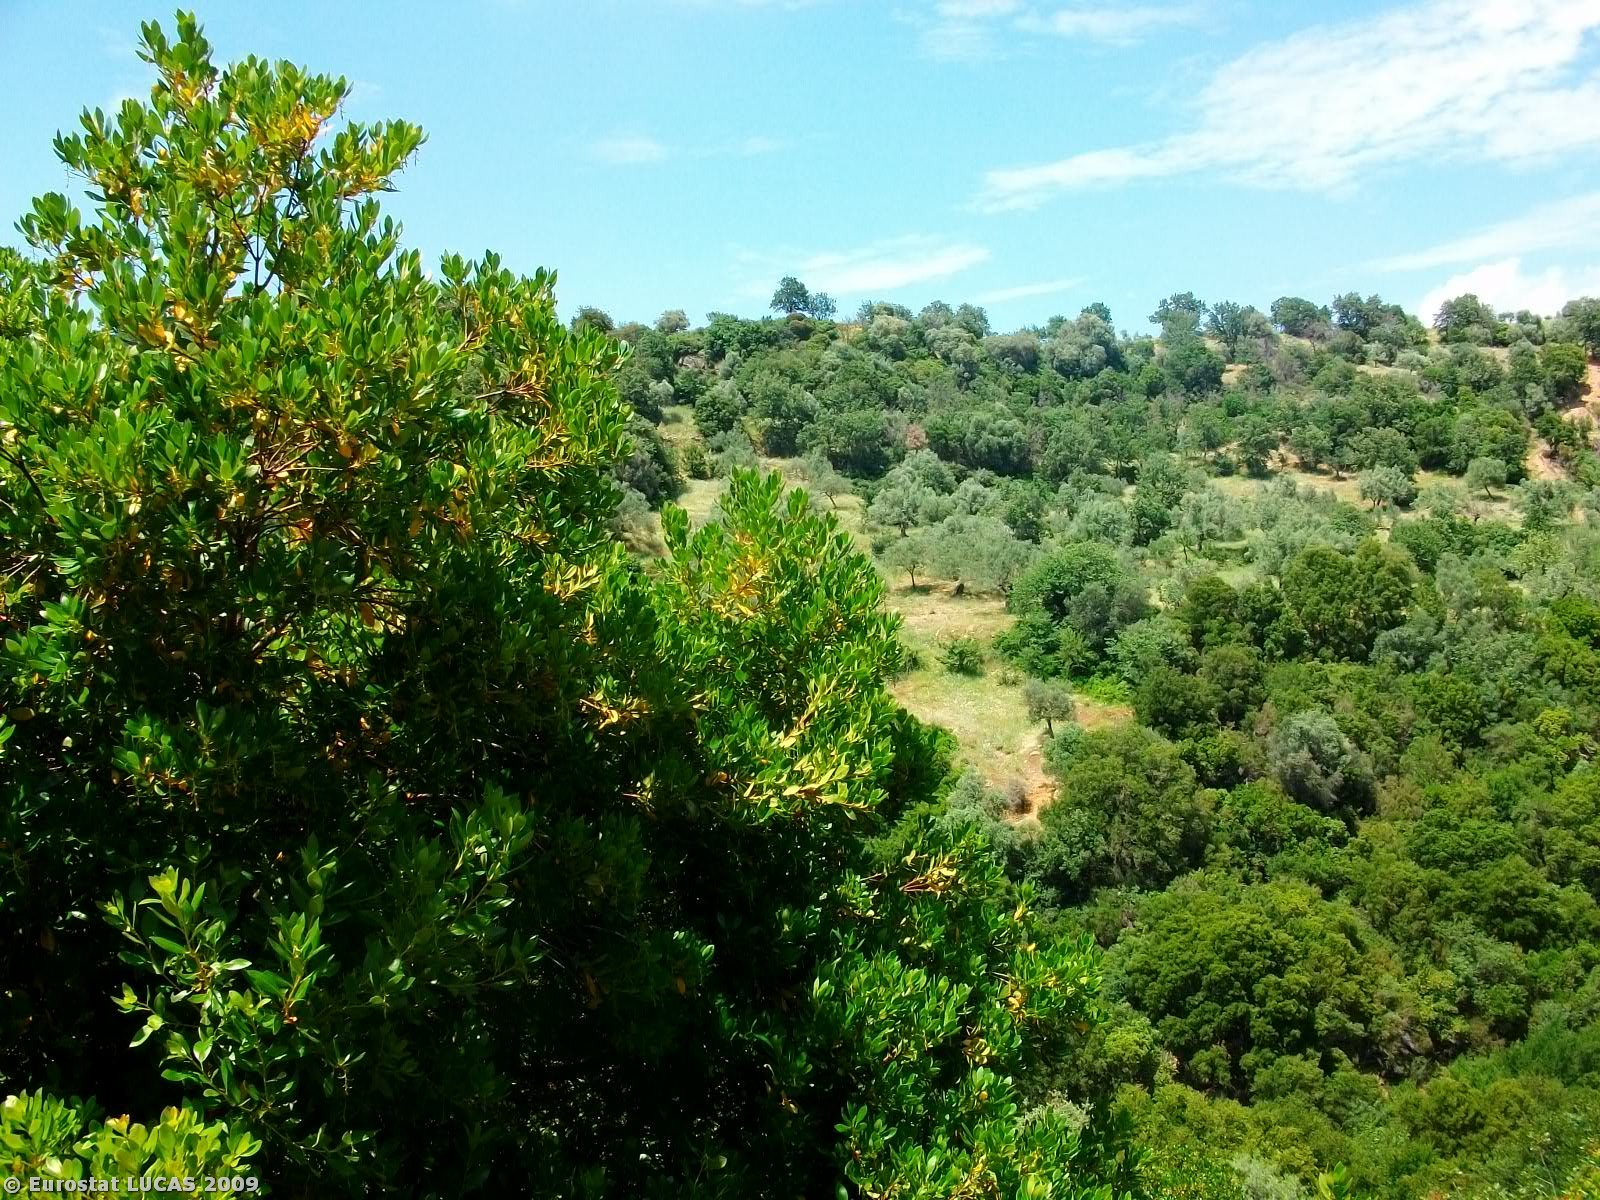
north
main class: Cropland
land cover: Olive groves
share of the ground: 25 - 50 %
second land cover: Bare land
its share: 50 - 75 %
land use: Agriculture (excluding fallow land and kitchen gardens)
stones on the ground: 25 - 50 %
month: May
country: GR
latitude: 37.1198
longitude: 22.3702
